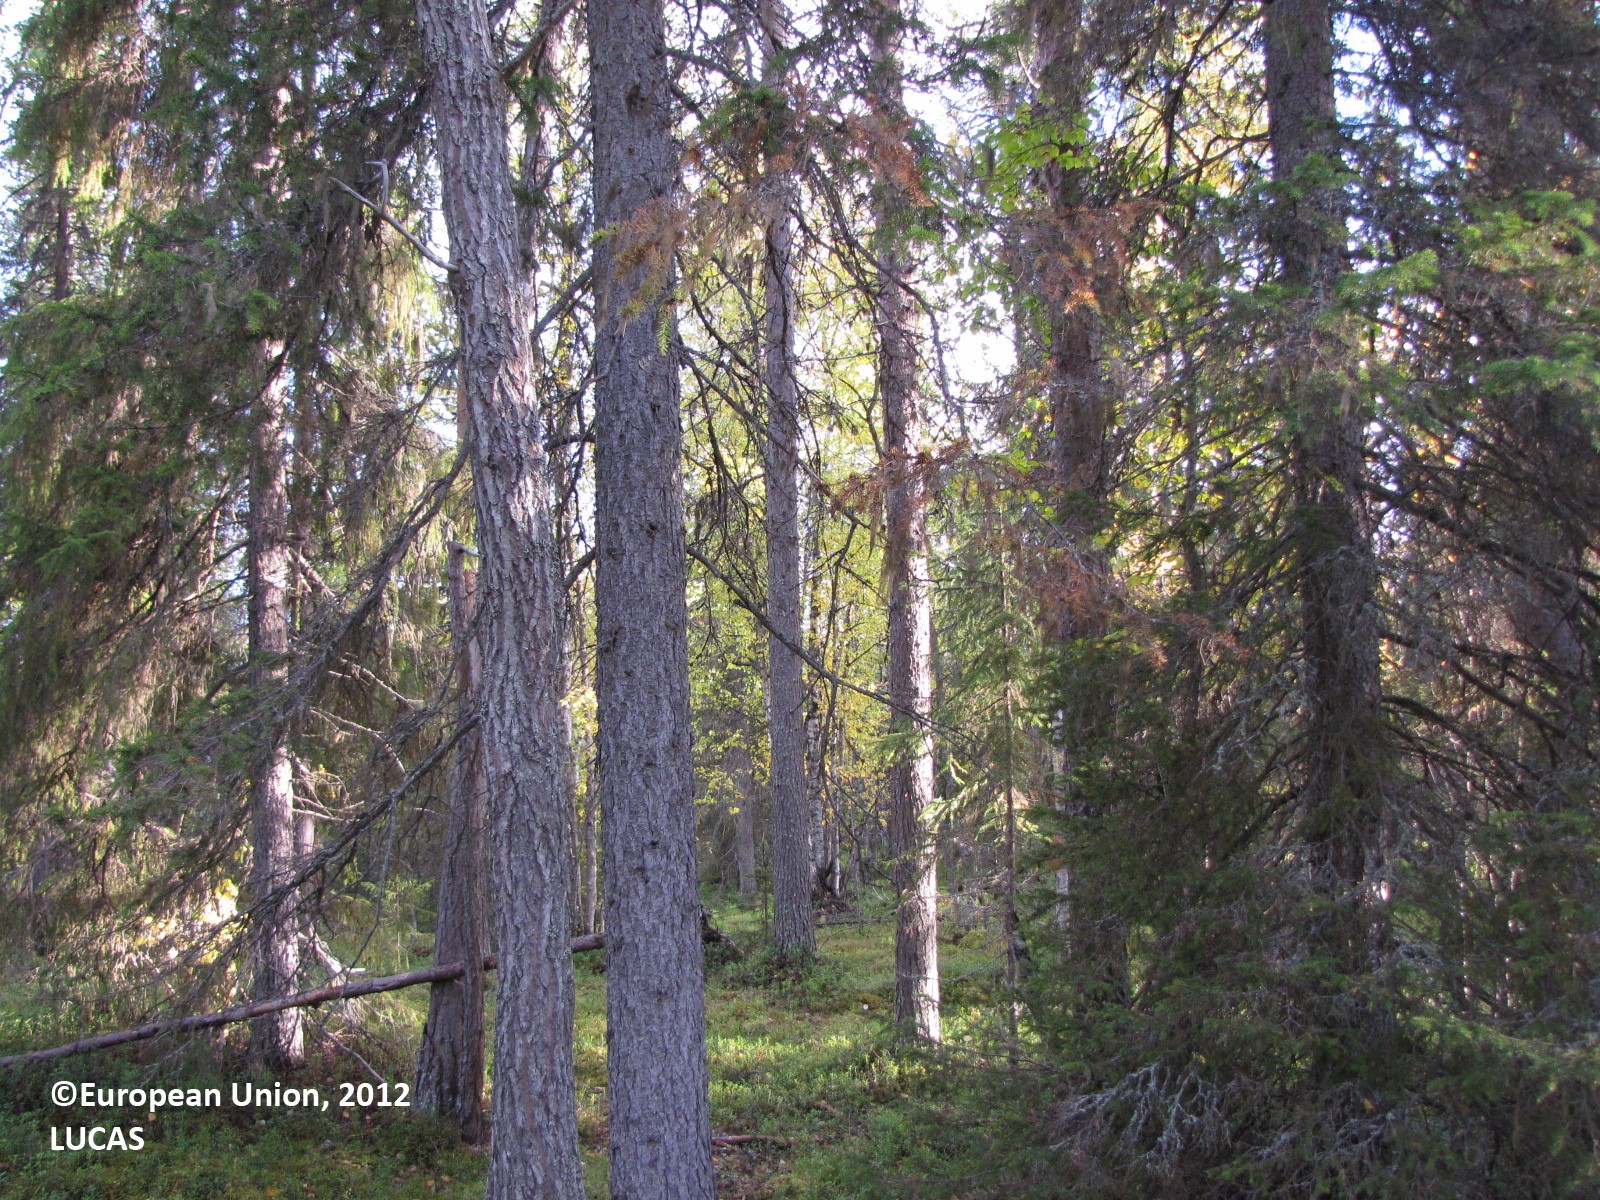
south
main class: Woodland
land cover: Other mixed woodland
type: boreal forest
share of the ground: 25 - 50 %
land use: Forestry
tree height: > 5 m
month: September
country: FI
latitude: 67.3314
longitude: 25.3243
